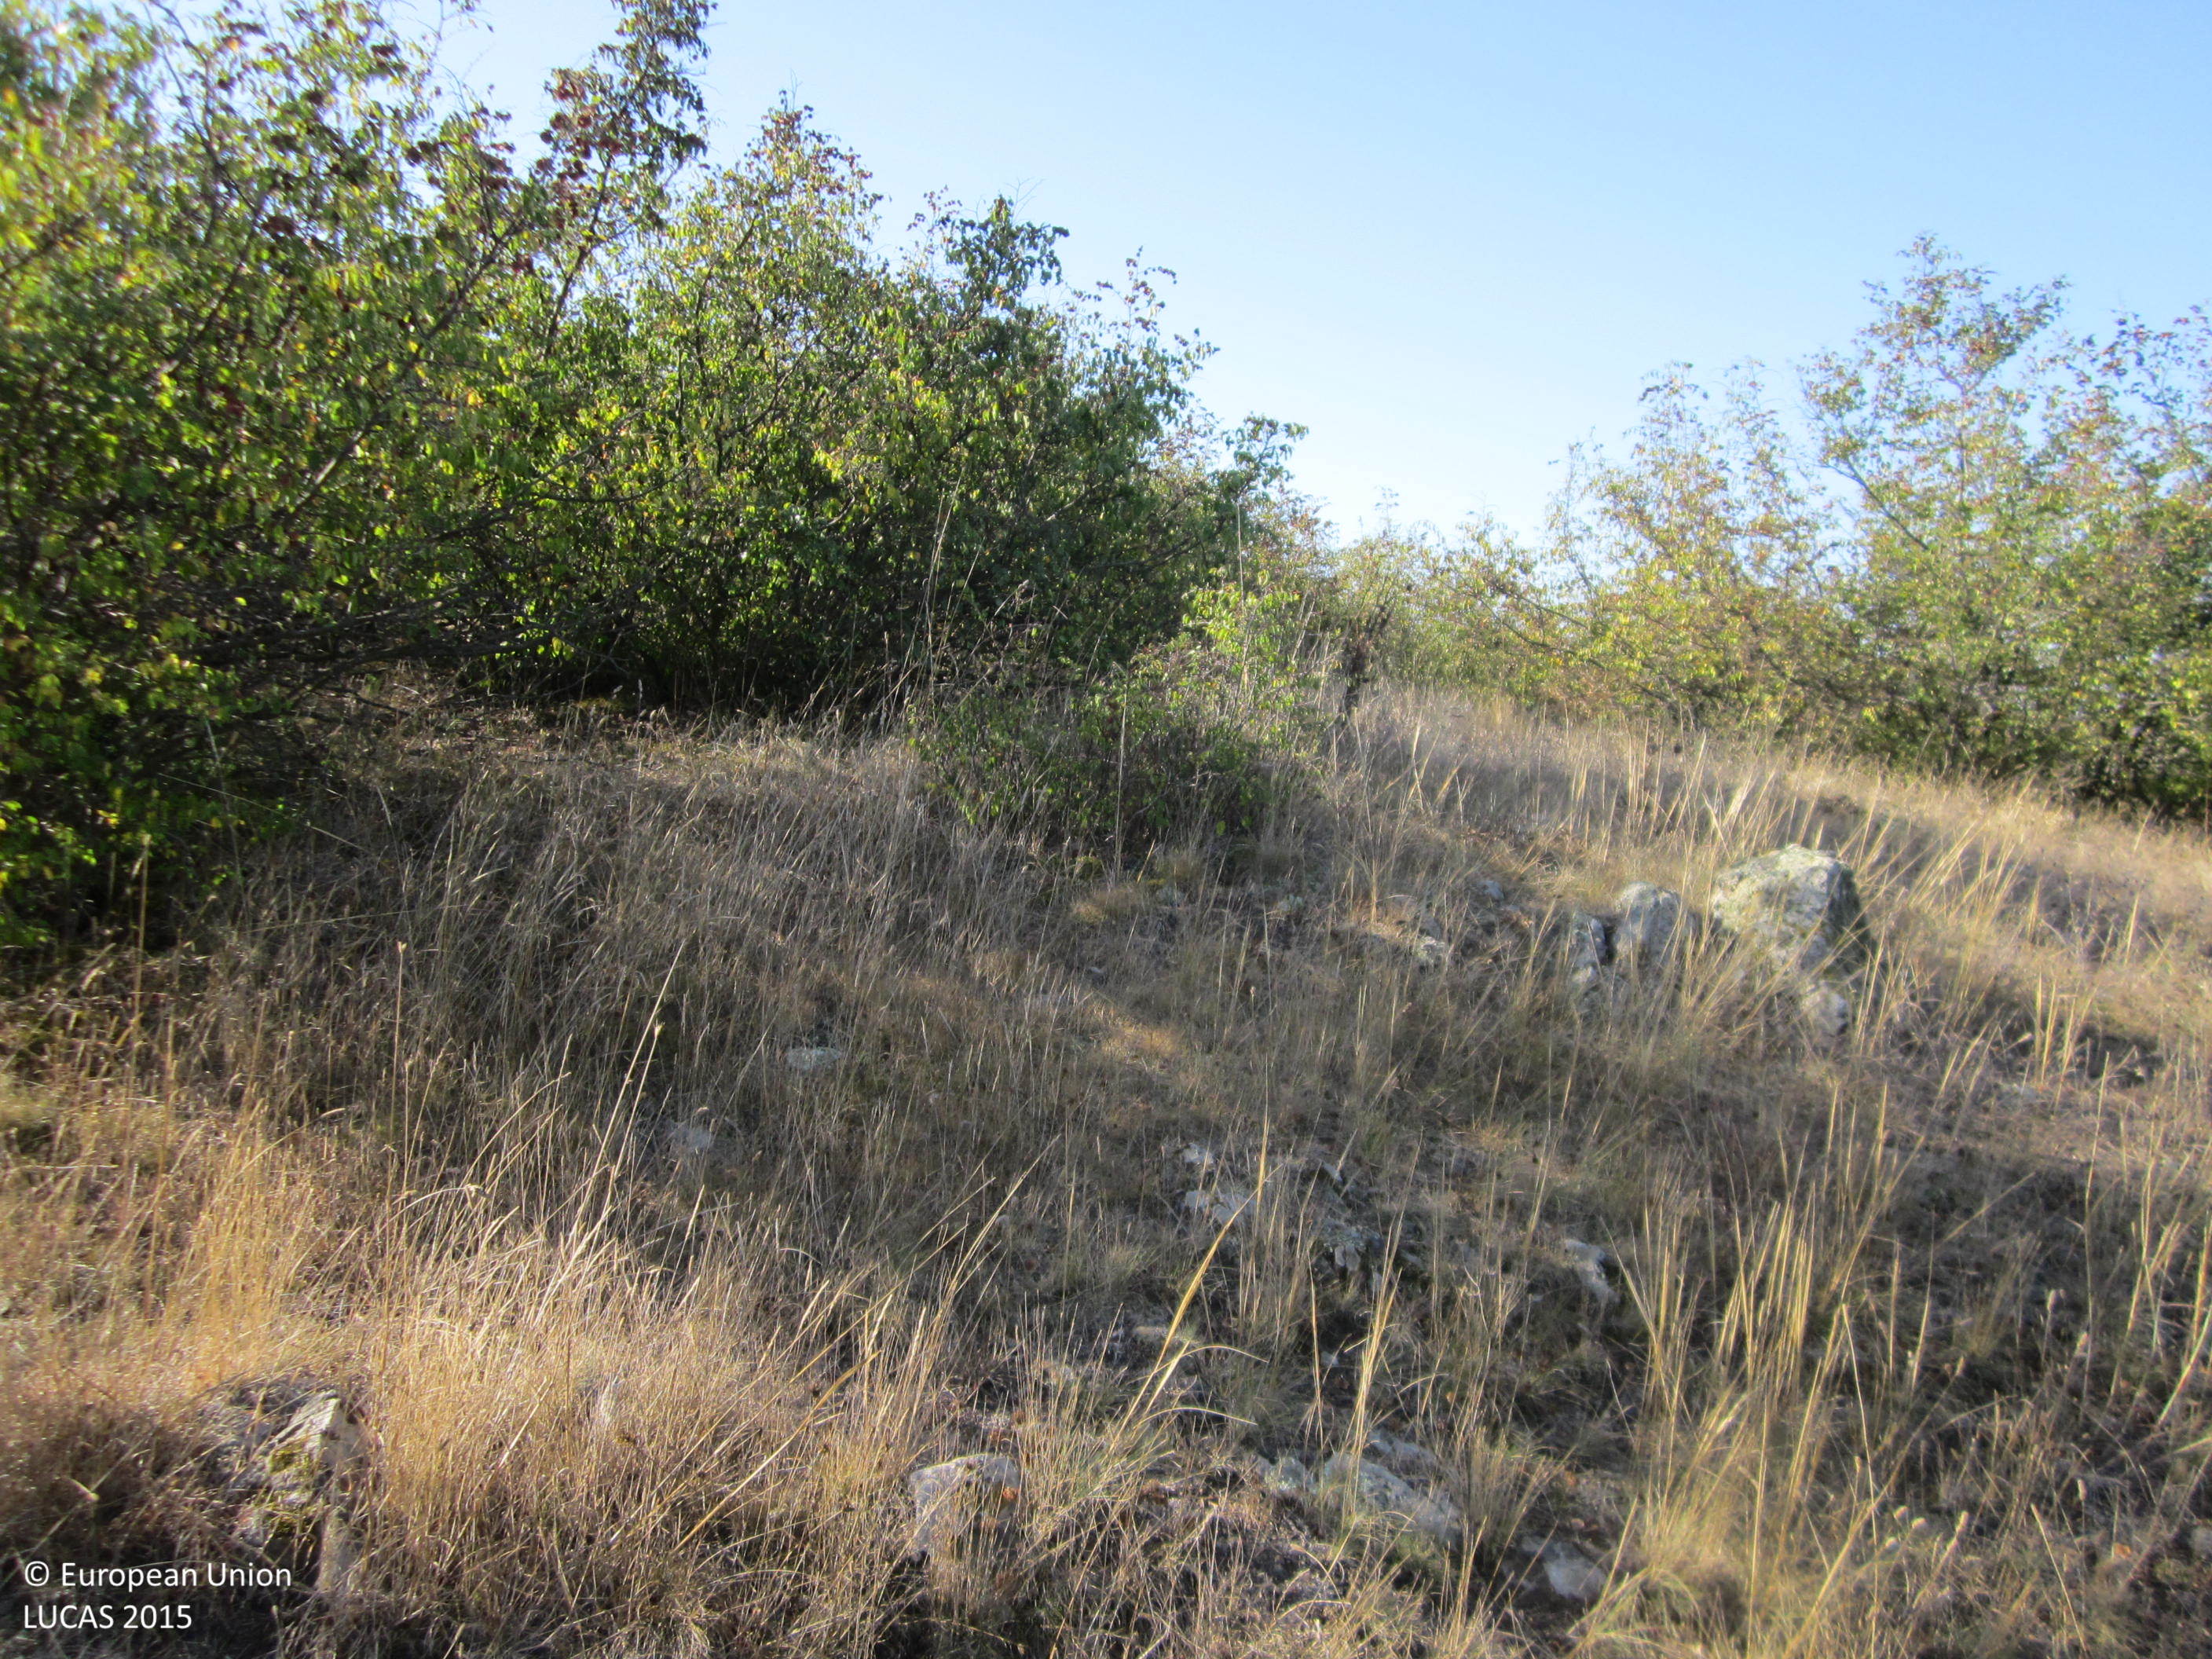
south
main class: Shrubland
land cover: Shrubland without tree cover
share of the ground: 50 - 75 %
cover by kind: shrubs 70 %, herbaceous plants 30 %
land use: Agriculture (excluding fallow land and kitchen gardens)
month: September
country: BG
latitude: 42.6528
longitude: 27.2518
